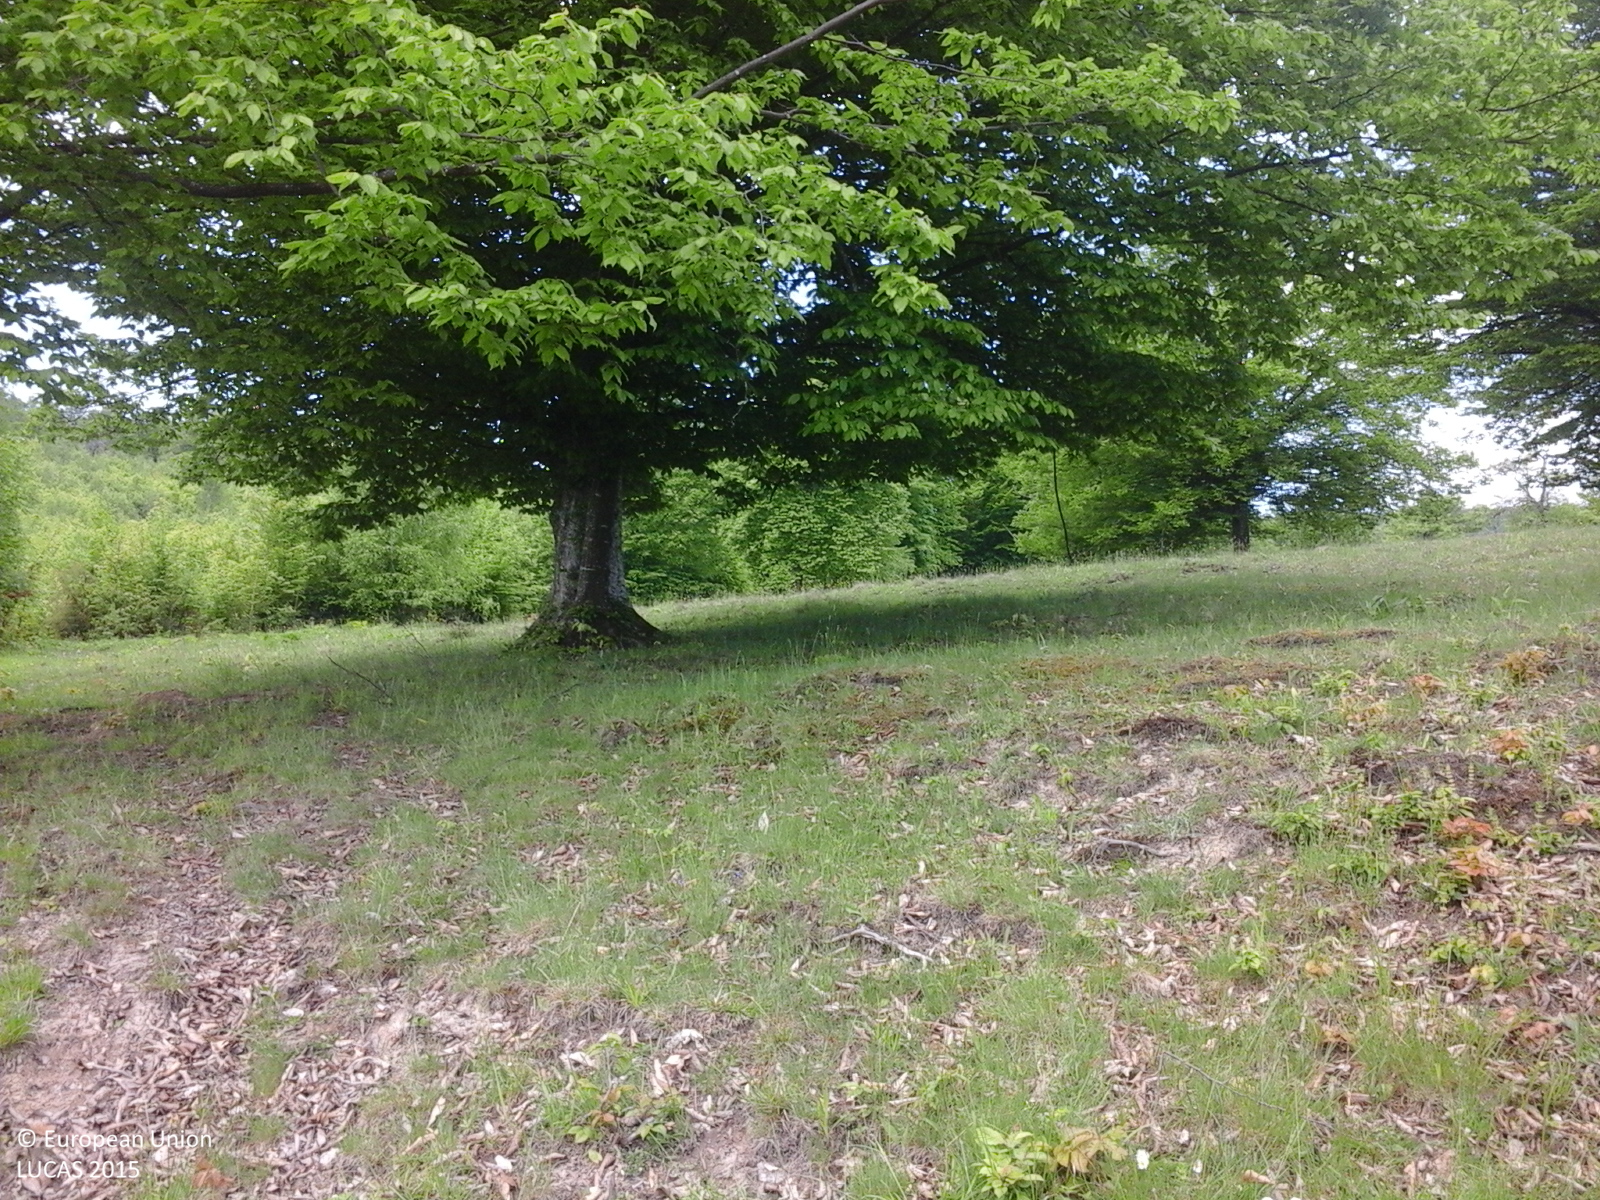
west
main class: Grassland
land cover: Grassland with sparse tree/shrub cover
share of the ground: > 75 %
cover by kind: herbaceous plants 85 %, shrubs 10 %, broadleaved forest trees 5 %
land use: Agriculture (excluding fallow land and kitchen gardens)
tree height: > 5 m
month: May
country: RO
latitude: 45.7403
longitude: 26.0137
